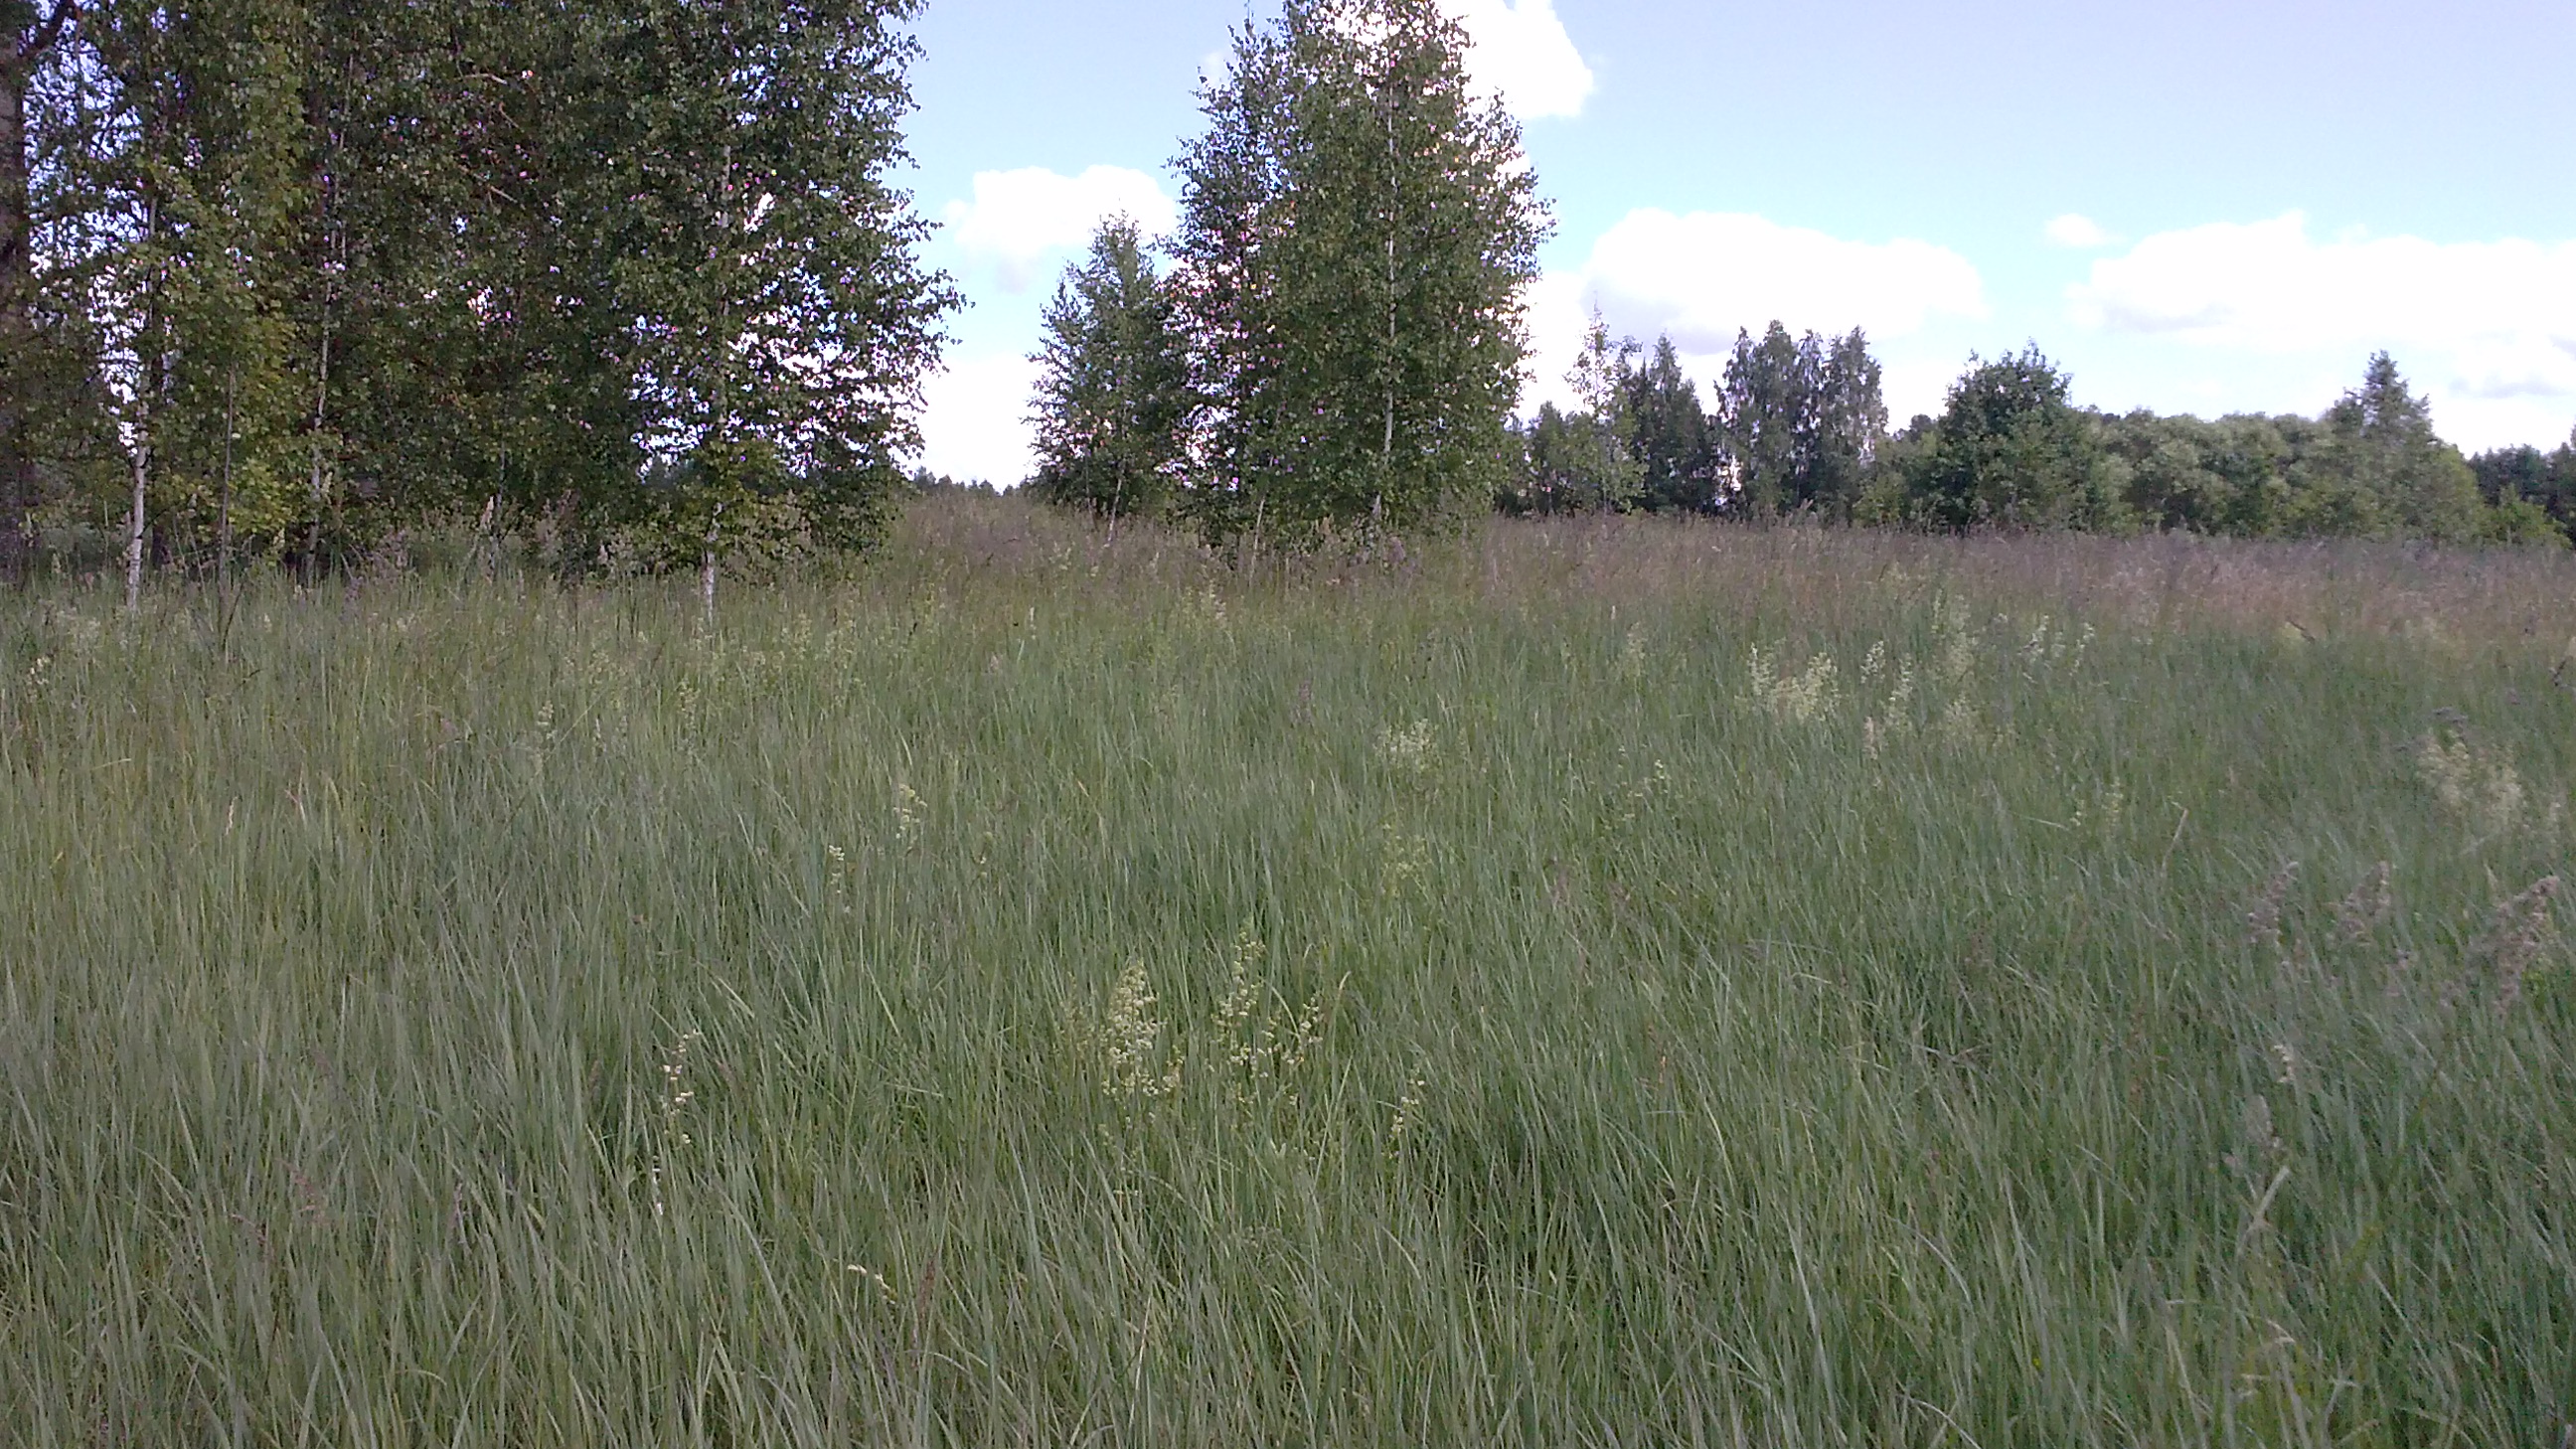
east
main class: Grassland
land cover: Grassland without tree/shrub cover
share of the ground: > 75 %
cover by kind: herbaceous plants 100 %
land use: Agriculture (excluding fallow land and kitchen gardens)
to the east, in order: Grassland without tree/shrub cover; Grassland with sparse tree/shrub cover; Grassland without tree/shrub cover; Grassland with sparse tree/shrub cover; Grassland without tree/shrub cover; Inland fresh water bodies; Grassland without tree/shrub cover
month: June
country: LV
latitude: 56.4825
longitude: 27.9088
